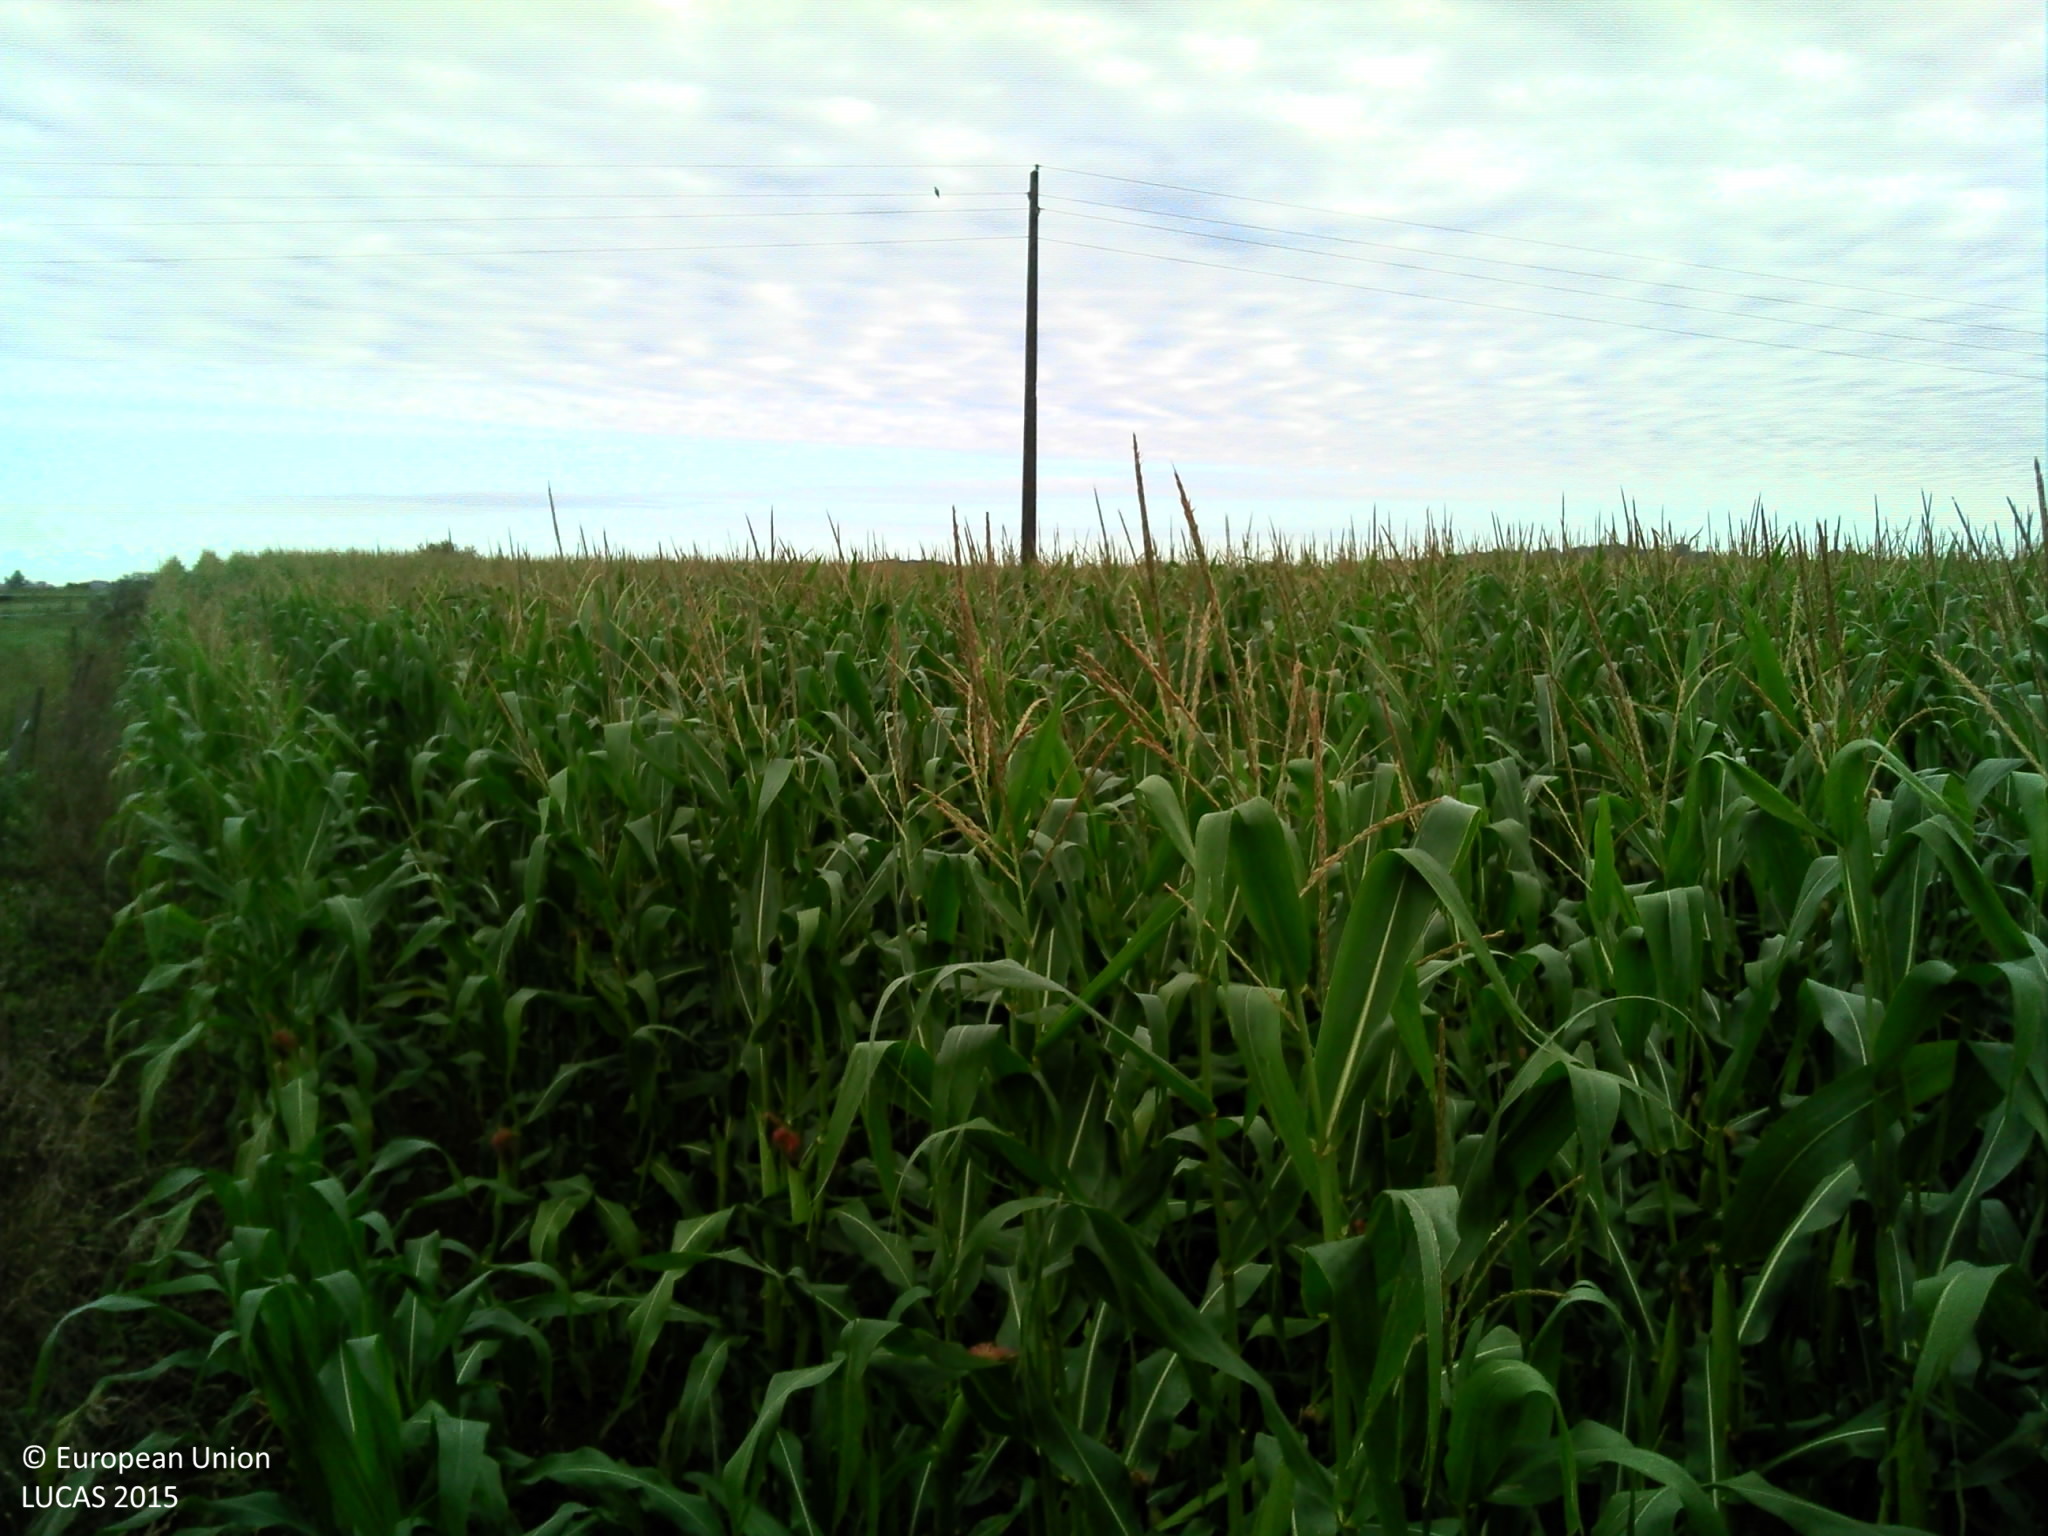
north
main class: Cropland
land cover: Maize
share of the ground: > 75 %
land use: Agriculture (excluding fallow land and kitchen gardens)
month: September
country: FR
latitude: 43.4706
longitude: -0.5040
